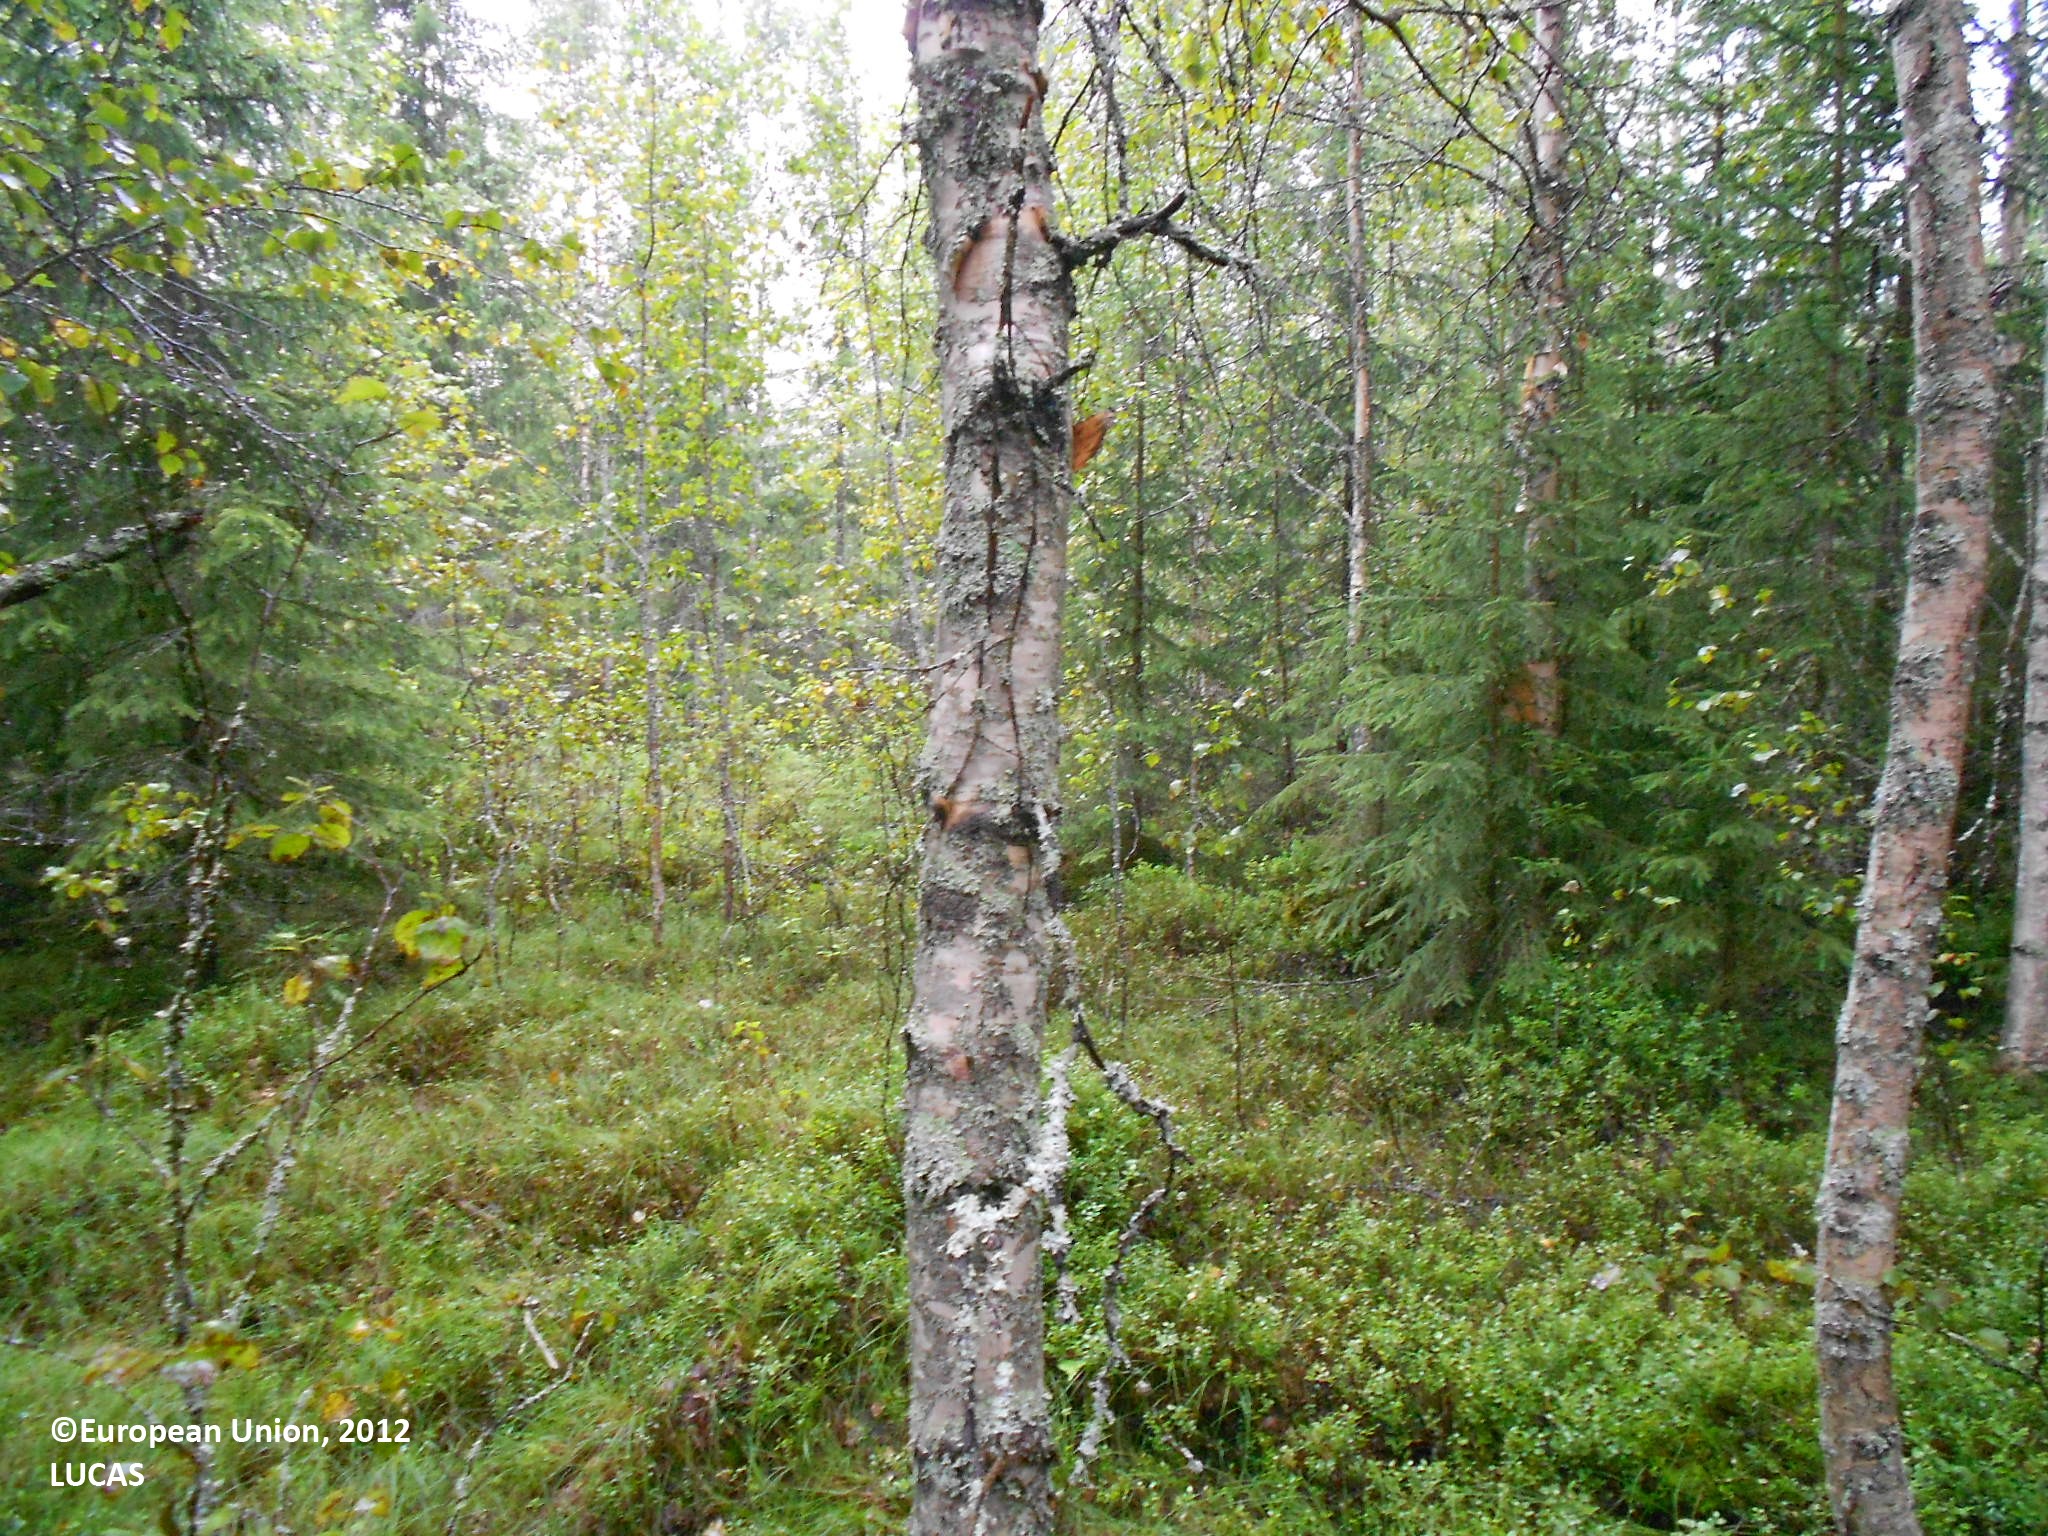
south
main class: Woodland
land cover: Spruce dominated mixed woodland
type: boreal forest
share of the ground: > 75 %
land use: Forestry
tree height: > 5 m
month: August
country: FI
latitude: 63.9689
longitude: 28.1644
